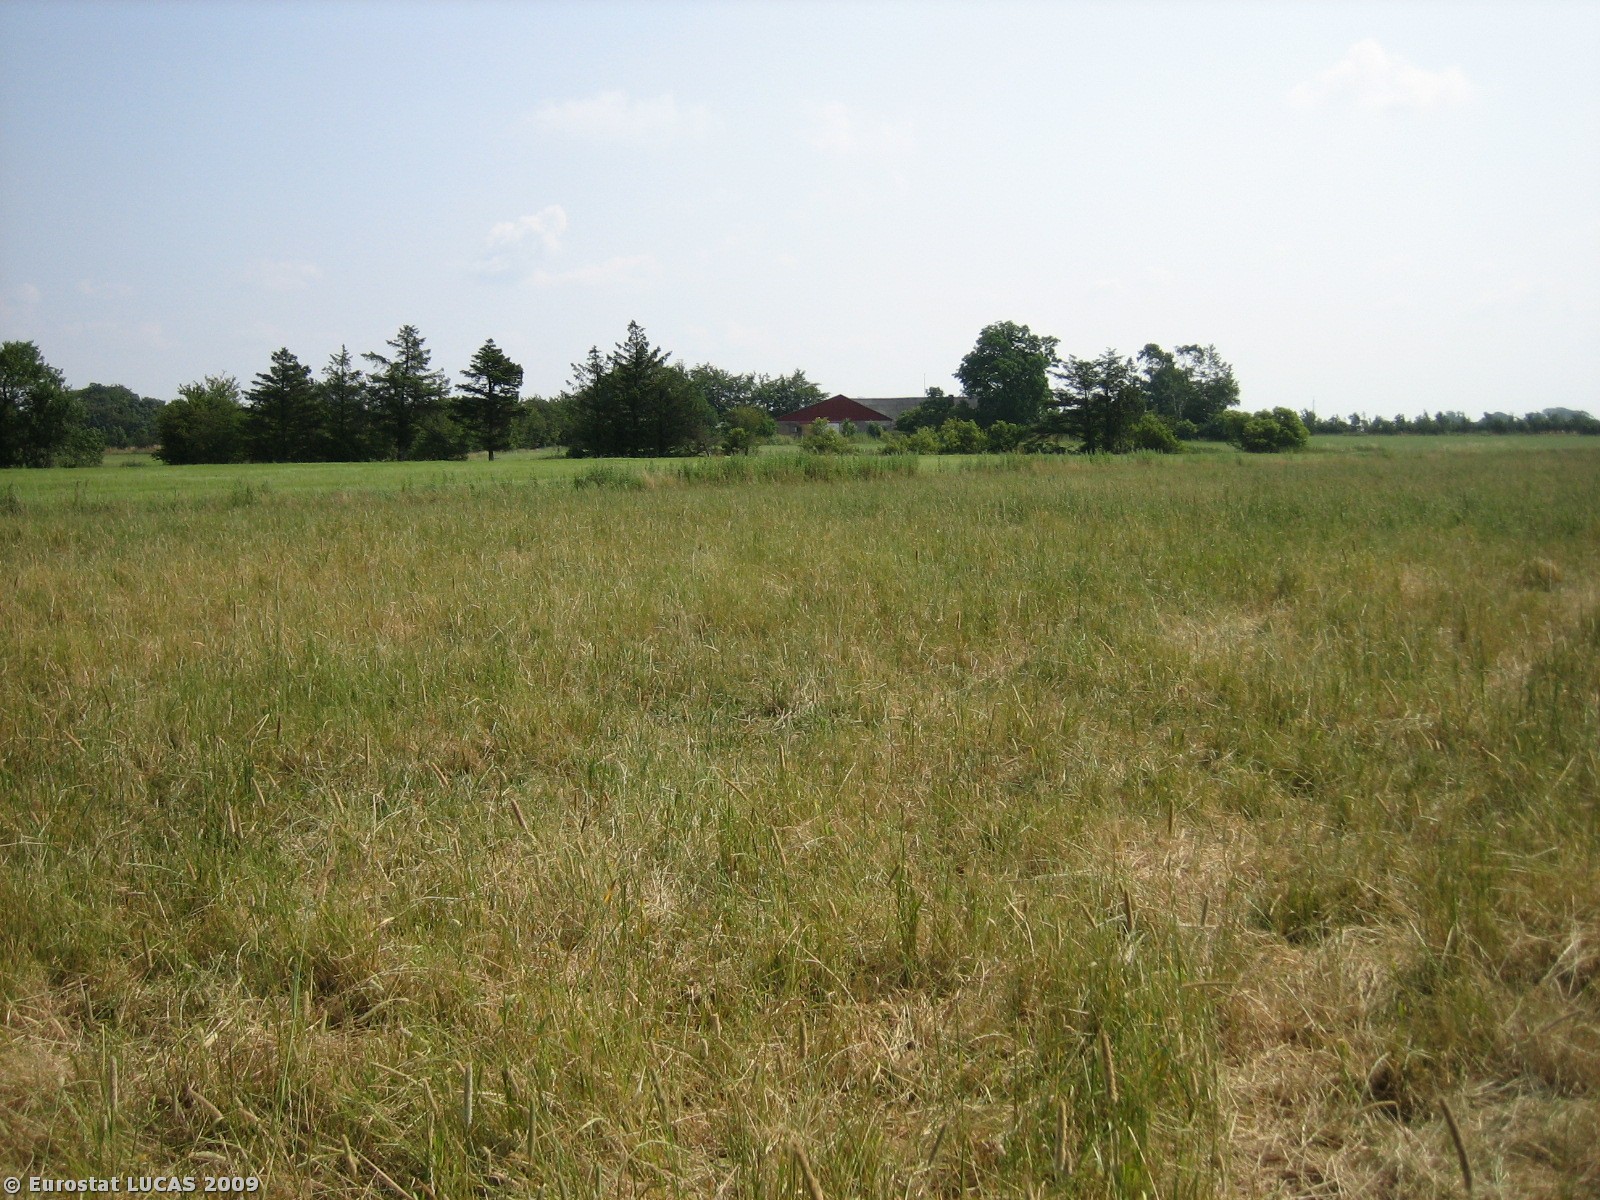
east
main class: Grassland
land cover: Grassland without tree/shrub cover
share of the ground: > 75 %
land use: Agriculture (excluding fallow land and kitchen gardens)
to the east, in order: Grassland without tree/shrub cover; Fences; Shruby margins; Barley; Grass margins; Shrubland with sparse tree cover; Temporary grasslands; Broadleaved woodland; Grassland without tree/shrub cover; Artificial constructions in urban areas
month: July
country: DK
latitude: 55.5354
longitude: 8.8444
